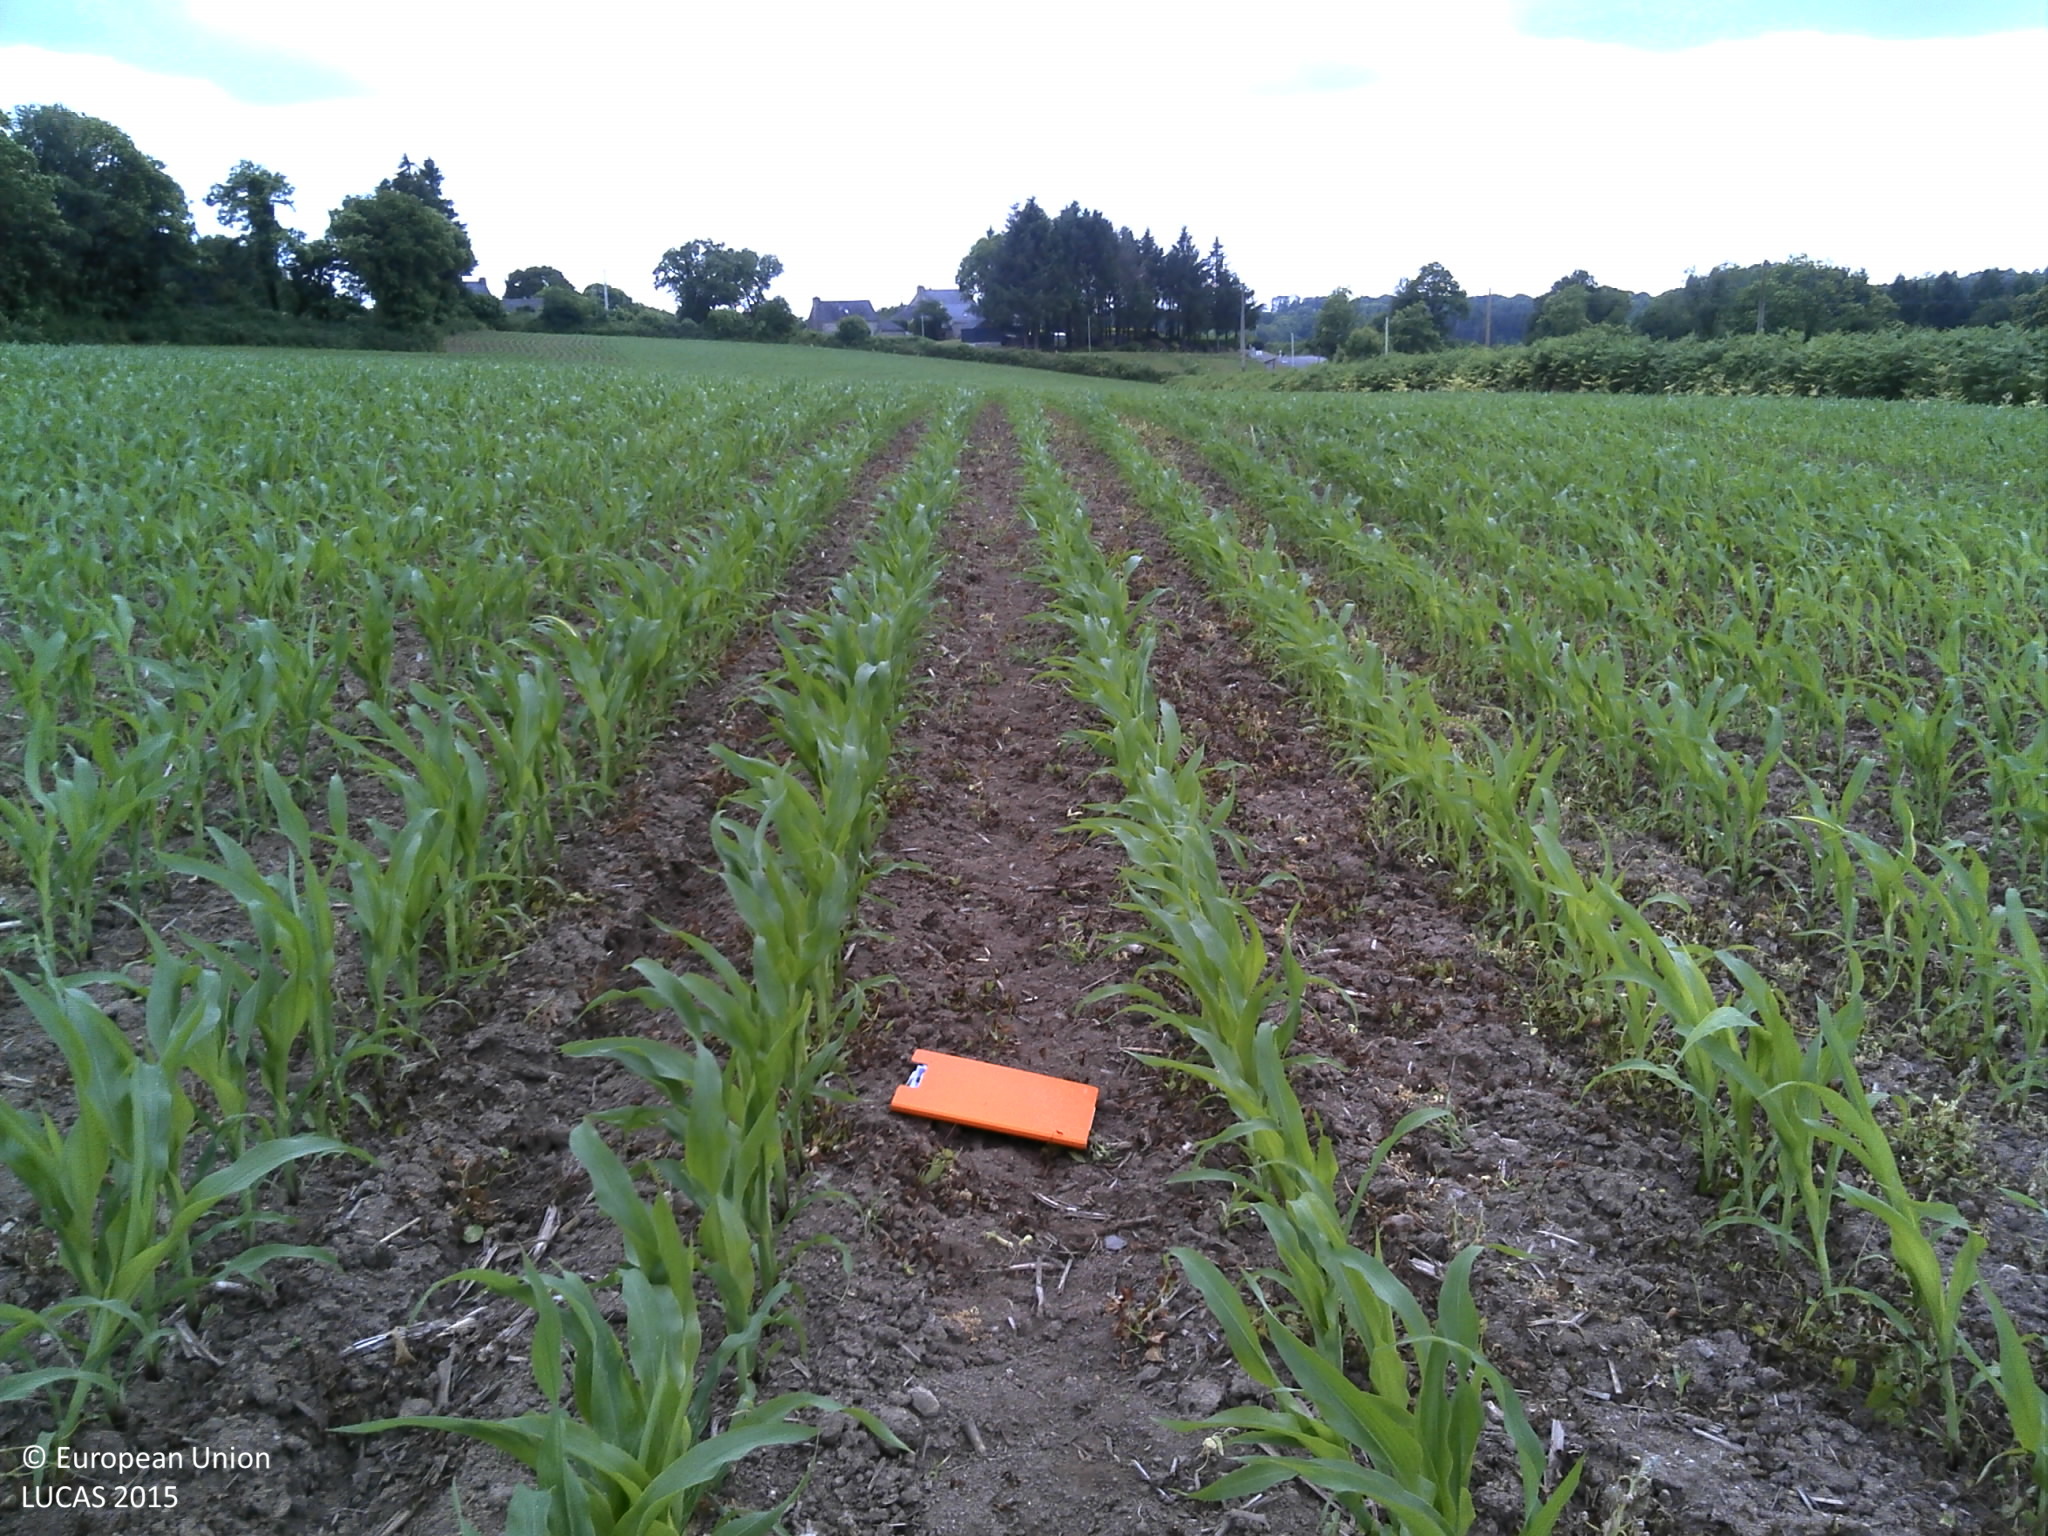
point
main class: Cropland
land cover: Maize
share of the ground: 50 - 75 %
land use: Agriculture (excluding fallow land and kitchen gardens)
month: June
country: FR
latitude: 47.9752
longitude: -3.6223
